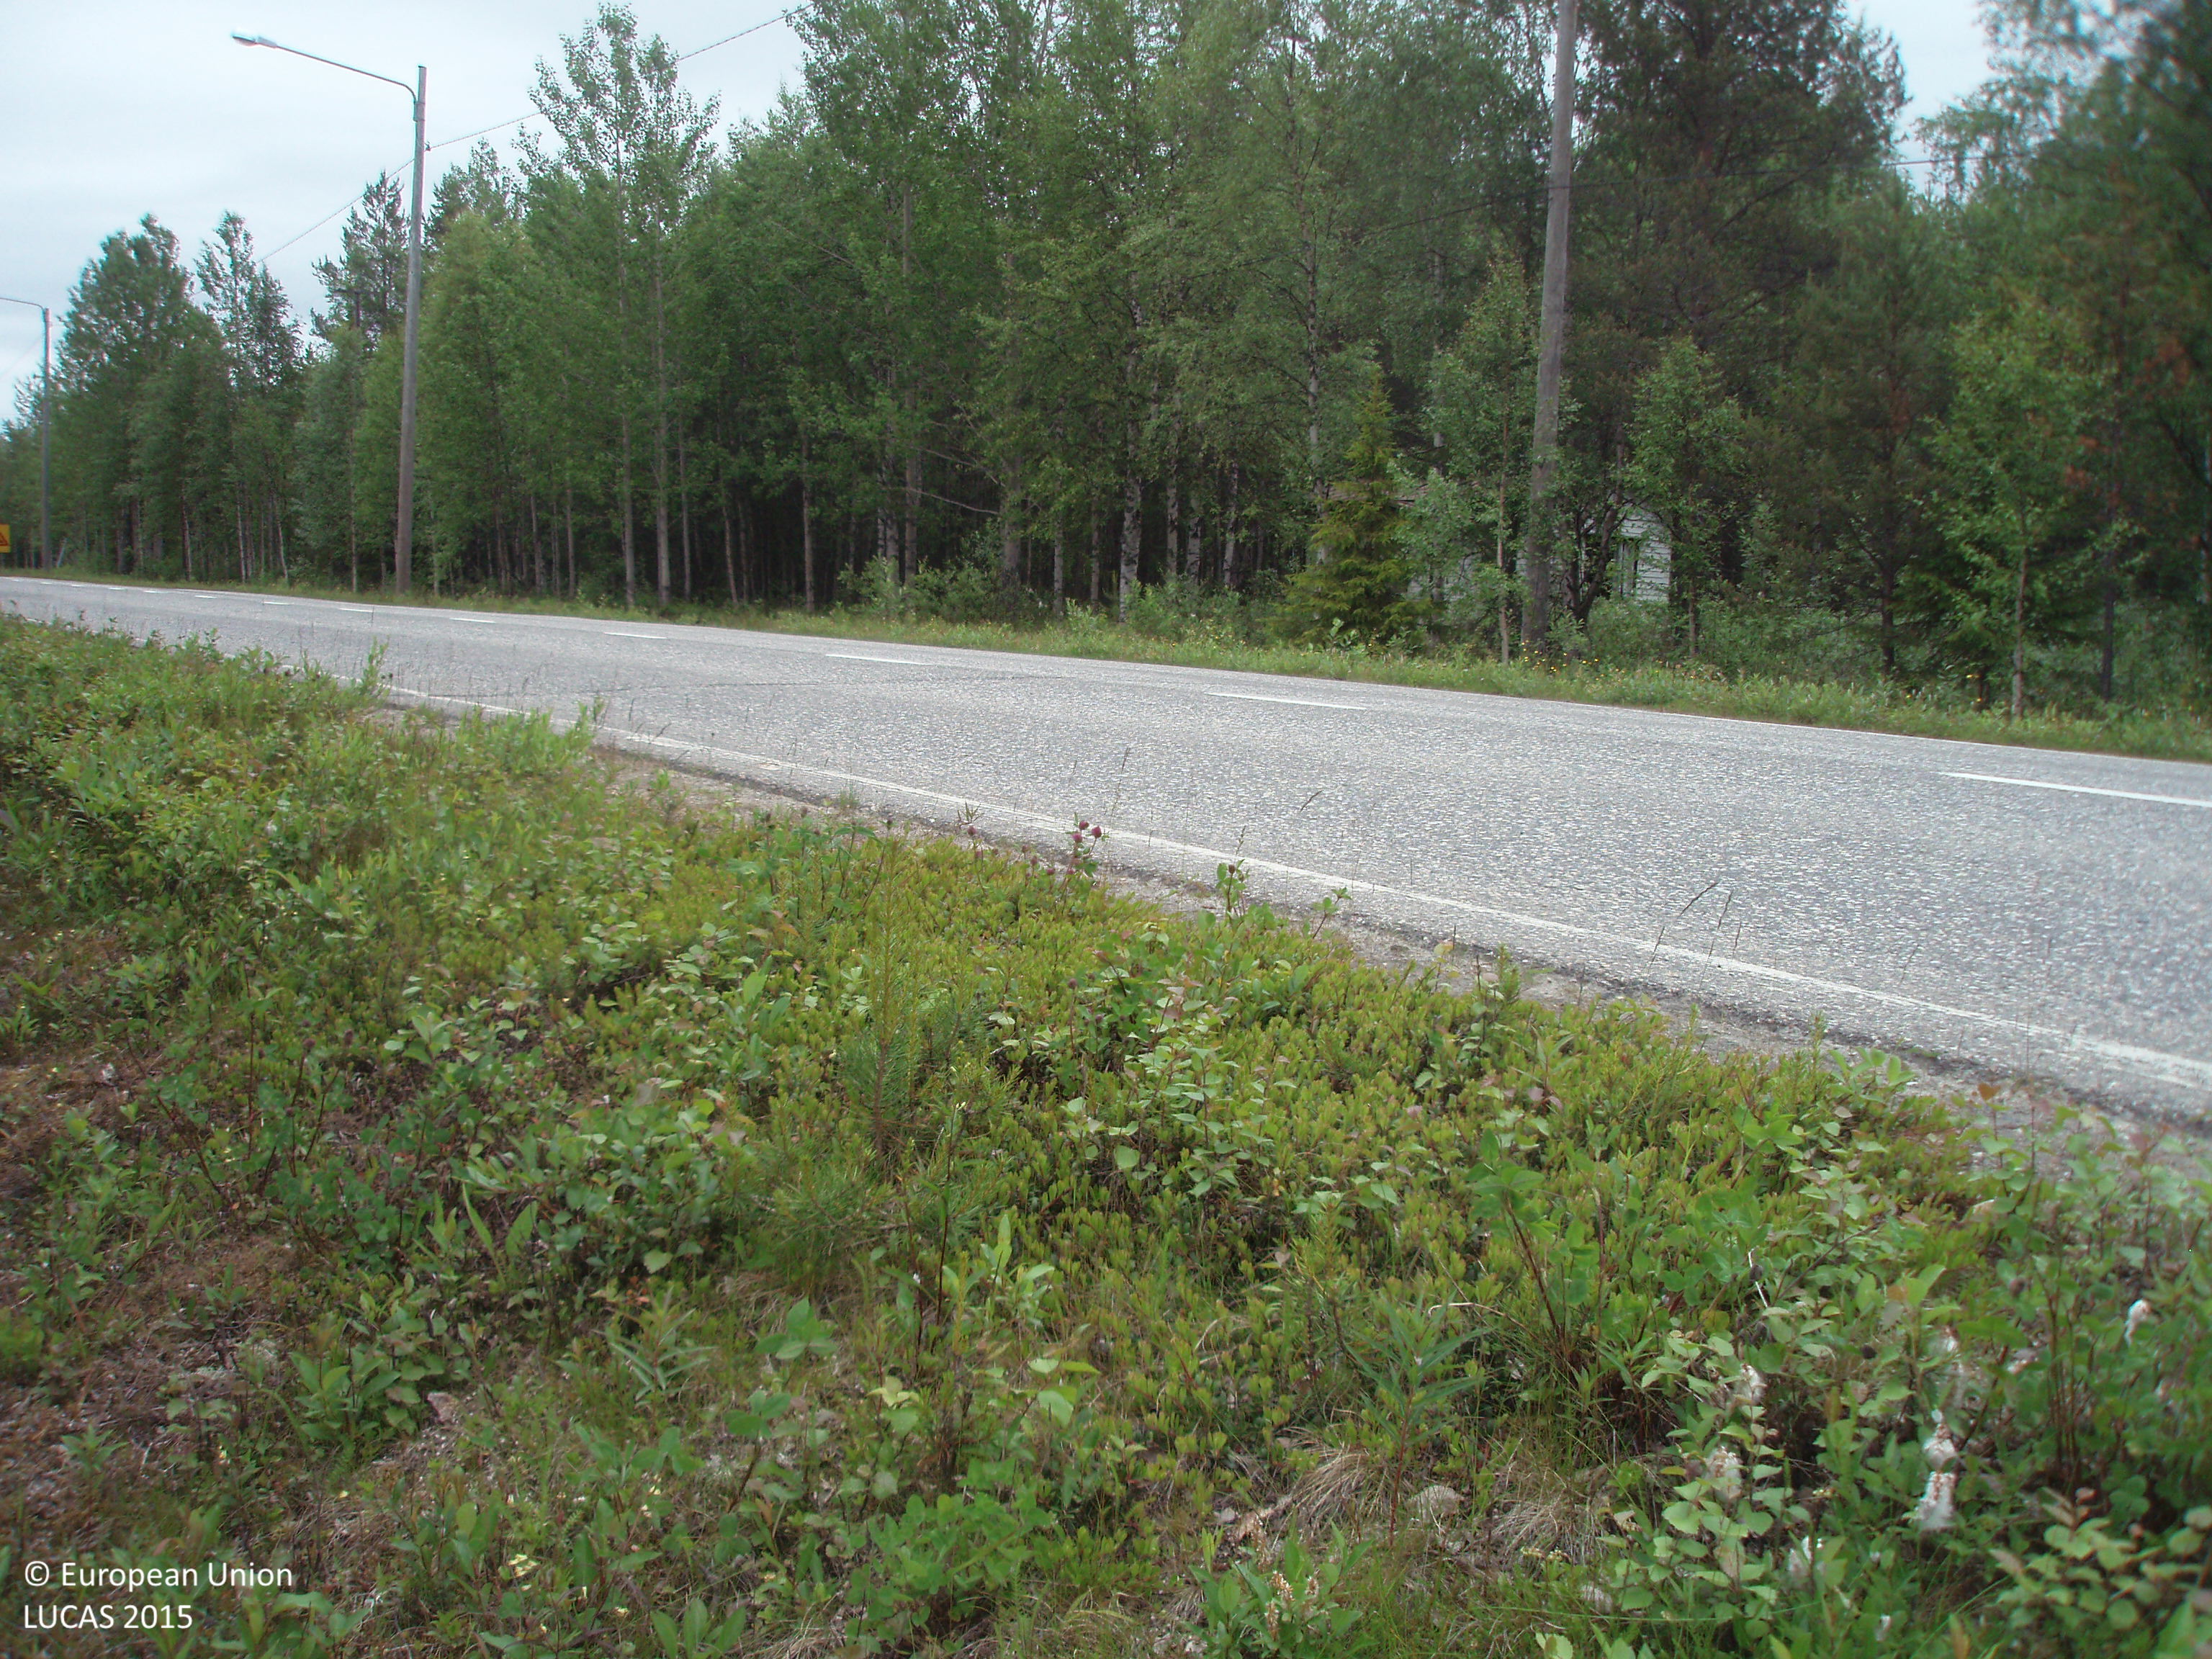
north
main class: Shrubland
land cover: Shrubland with sparse tree cover
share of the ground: > 75 %
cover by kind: shrubs 95 %, broadleaved forest trees 5 %
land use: Road transport
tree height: < 5 m
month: July
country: FI
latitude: 67.2982
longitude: 28.1626
